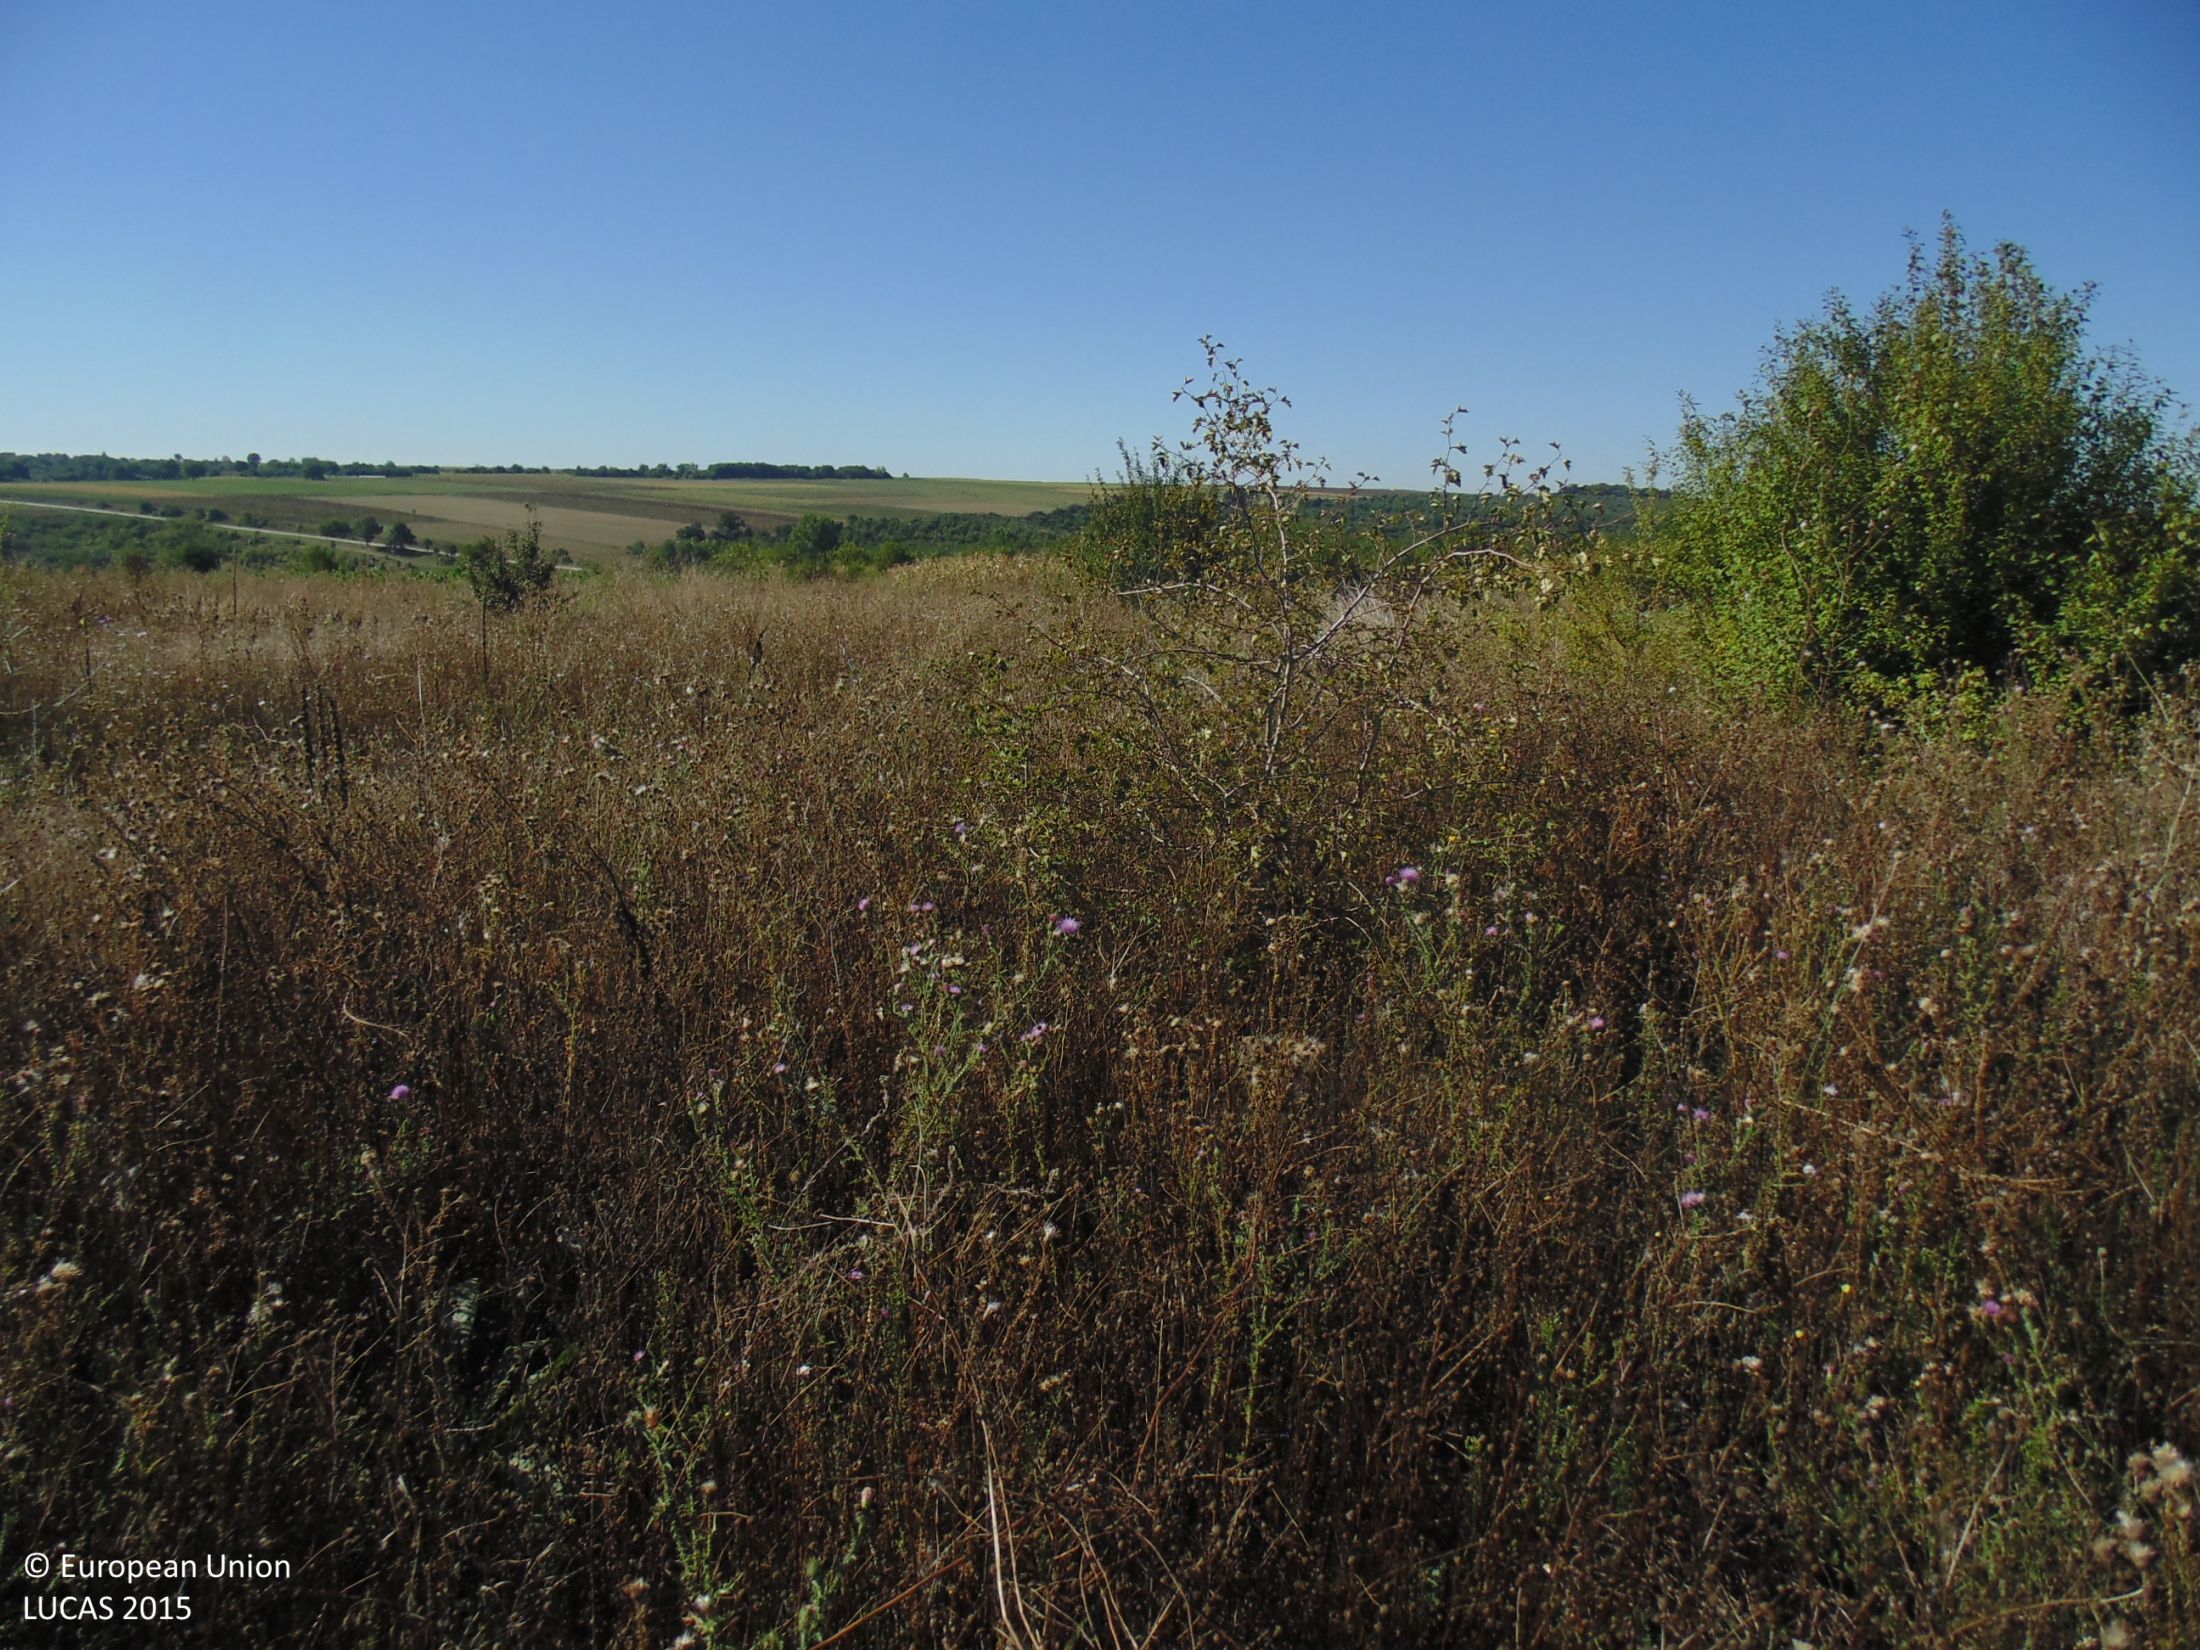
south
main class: Grassland
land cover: Grassland with sparse tree/shrub cover
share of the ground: > 75 %
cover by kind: herbaceous plants 90 %, broadleaved forest trees 5 %, shrubs 5 %
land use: Abandoned areas
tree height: < 5 m
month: September
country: BG
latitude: 43.7870
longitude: 27.1874
